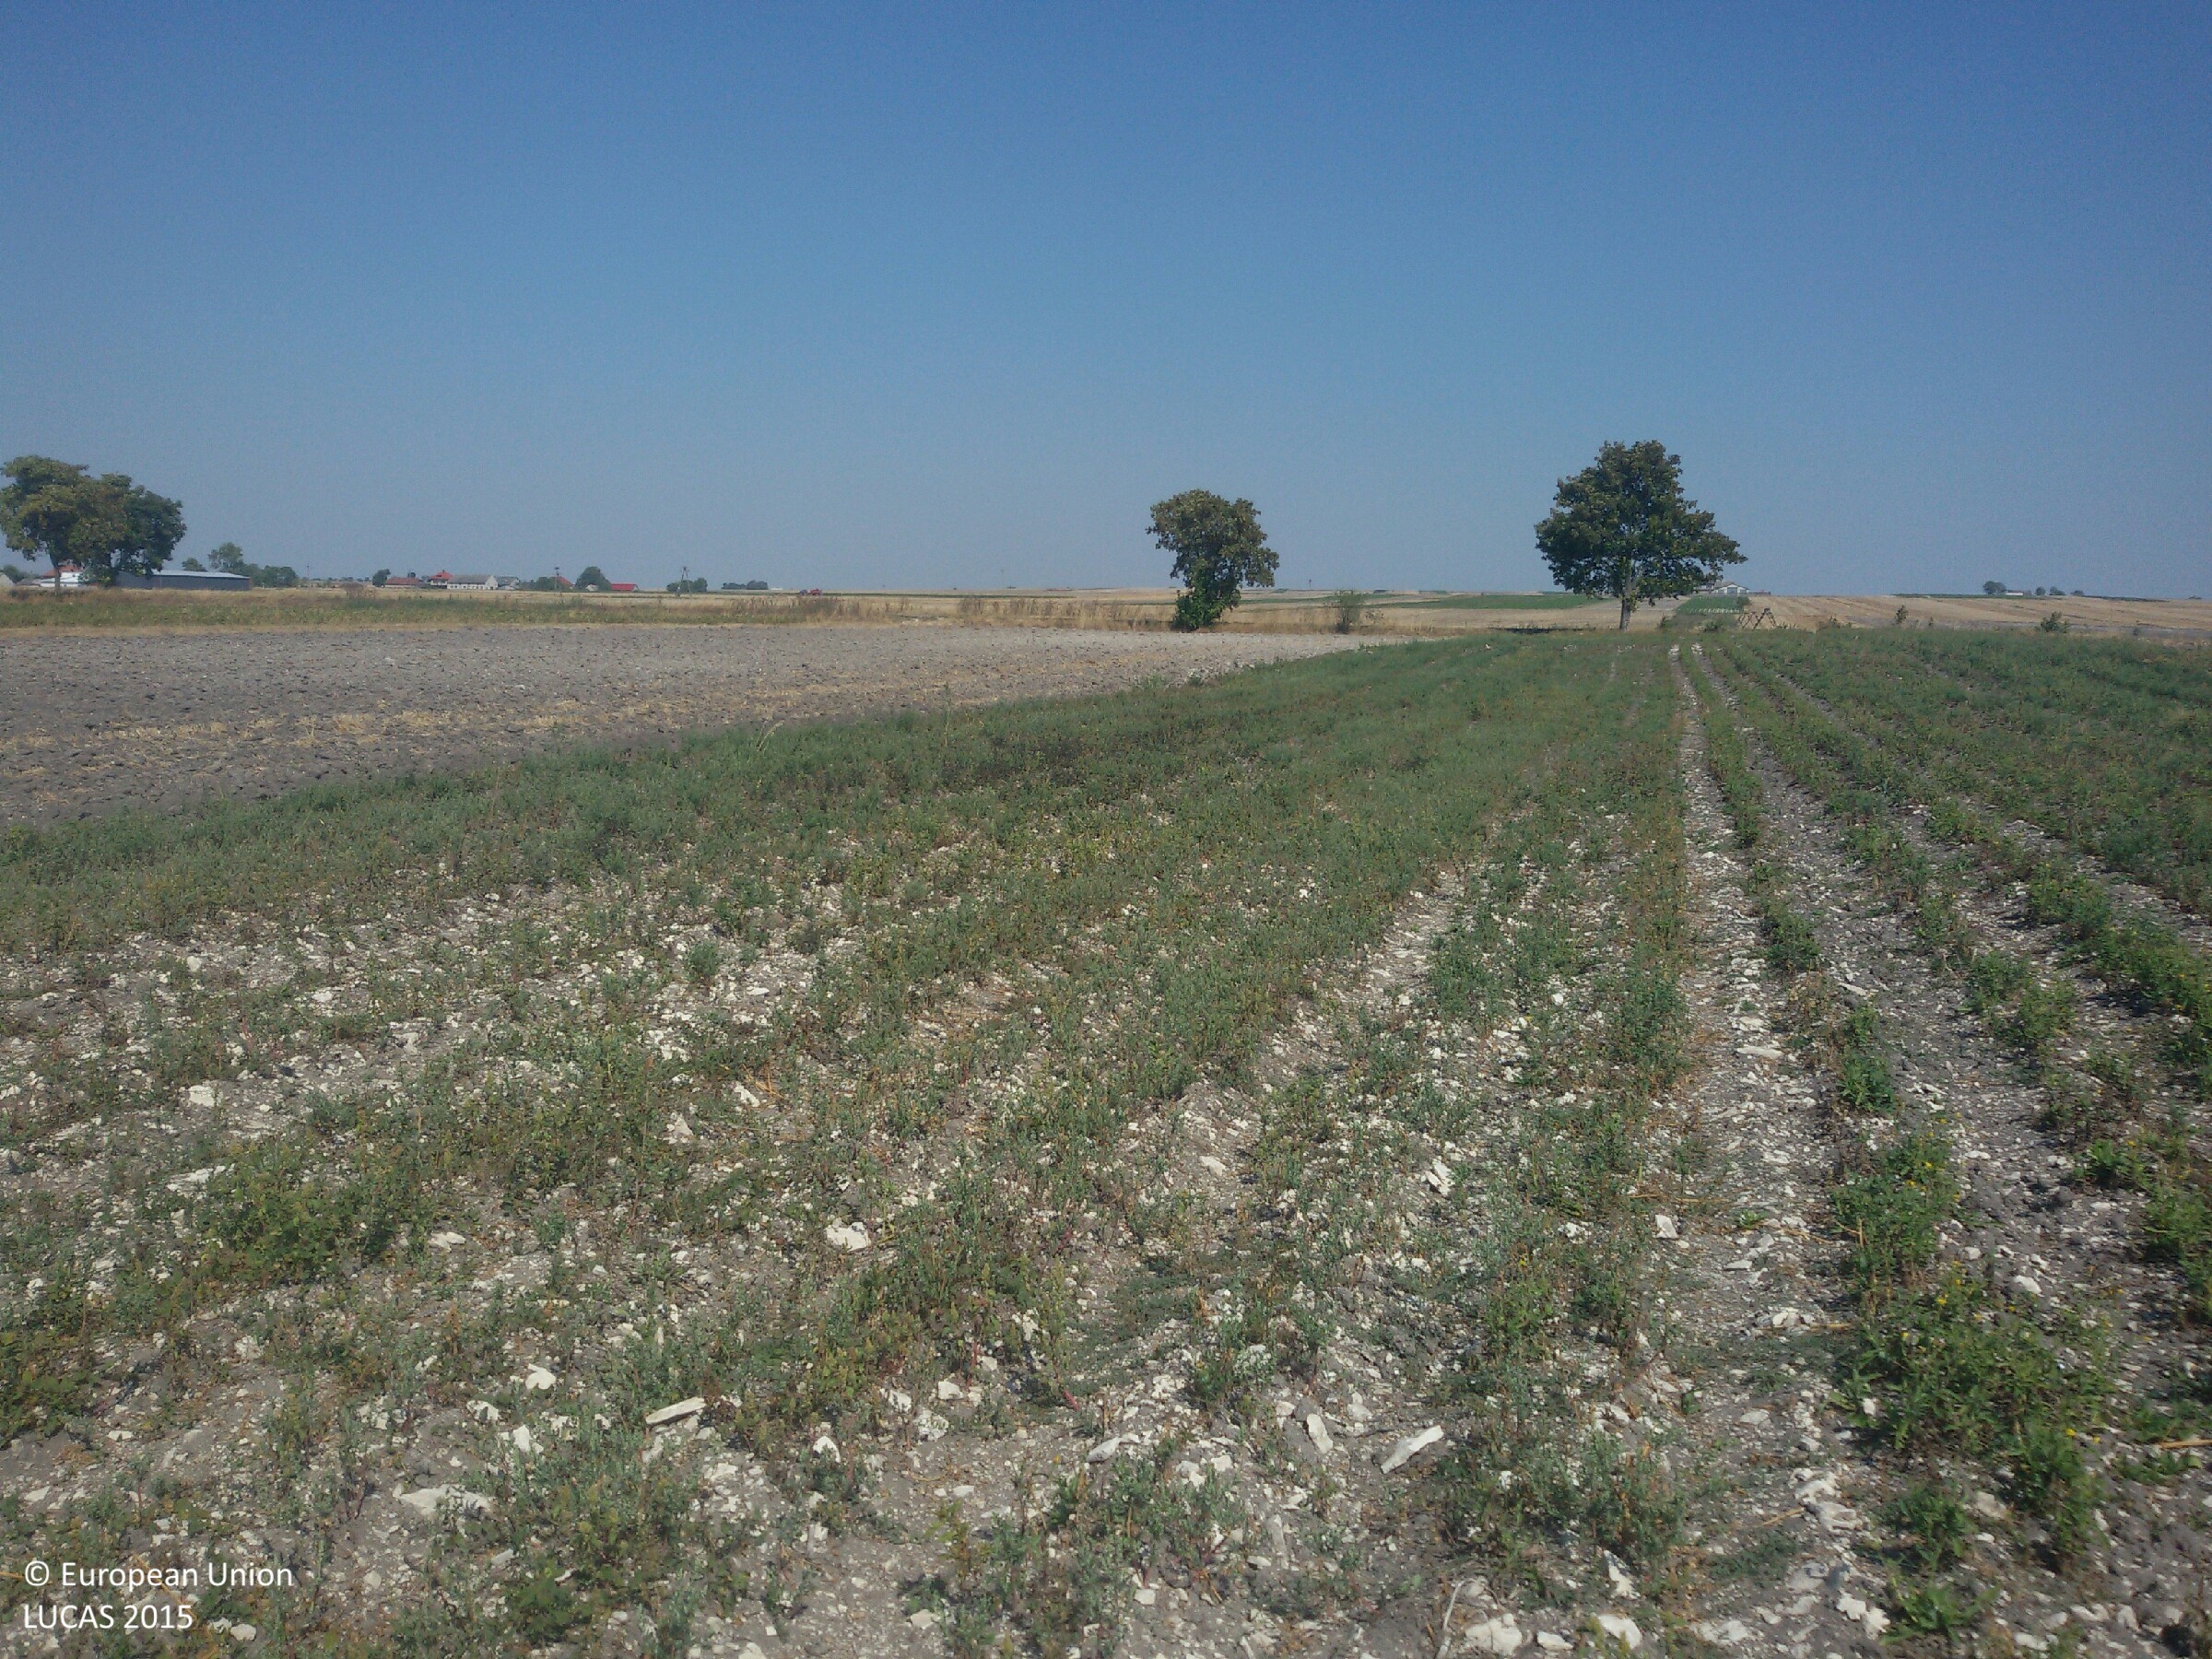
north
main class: Cropland
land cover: Other non-permanent industrial crops
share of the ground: 25 - 50 %
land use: Agriculture (excluding fallow land and kitchen gardens)
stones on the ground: 10 - 25 %
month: September
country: PL
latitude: 50.5102
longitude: 20.3444
